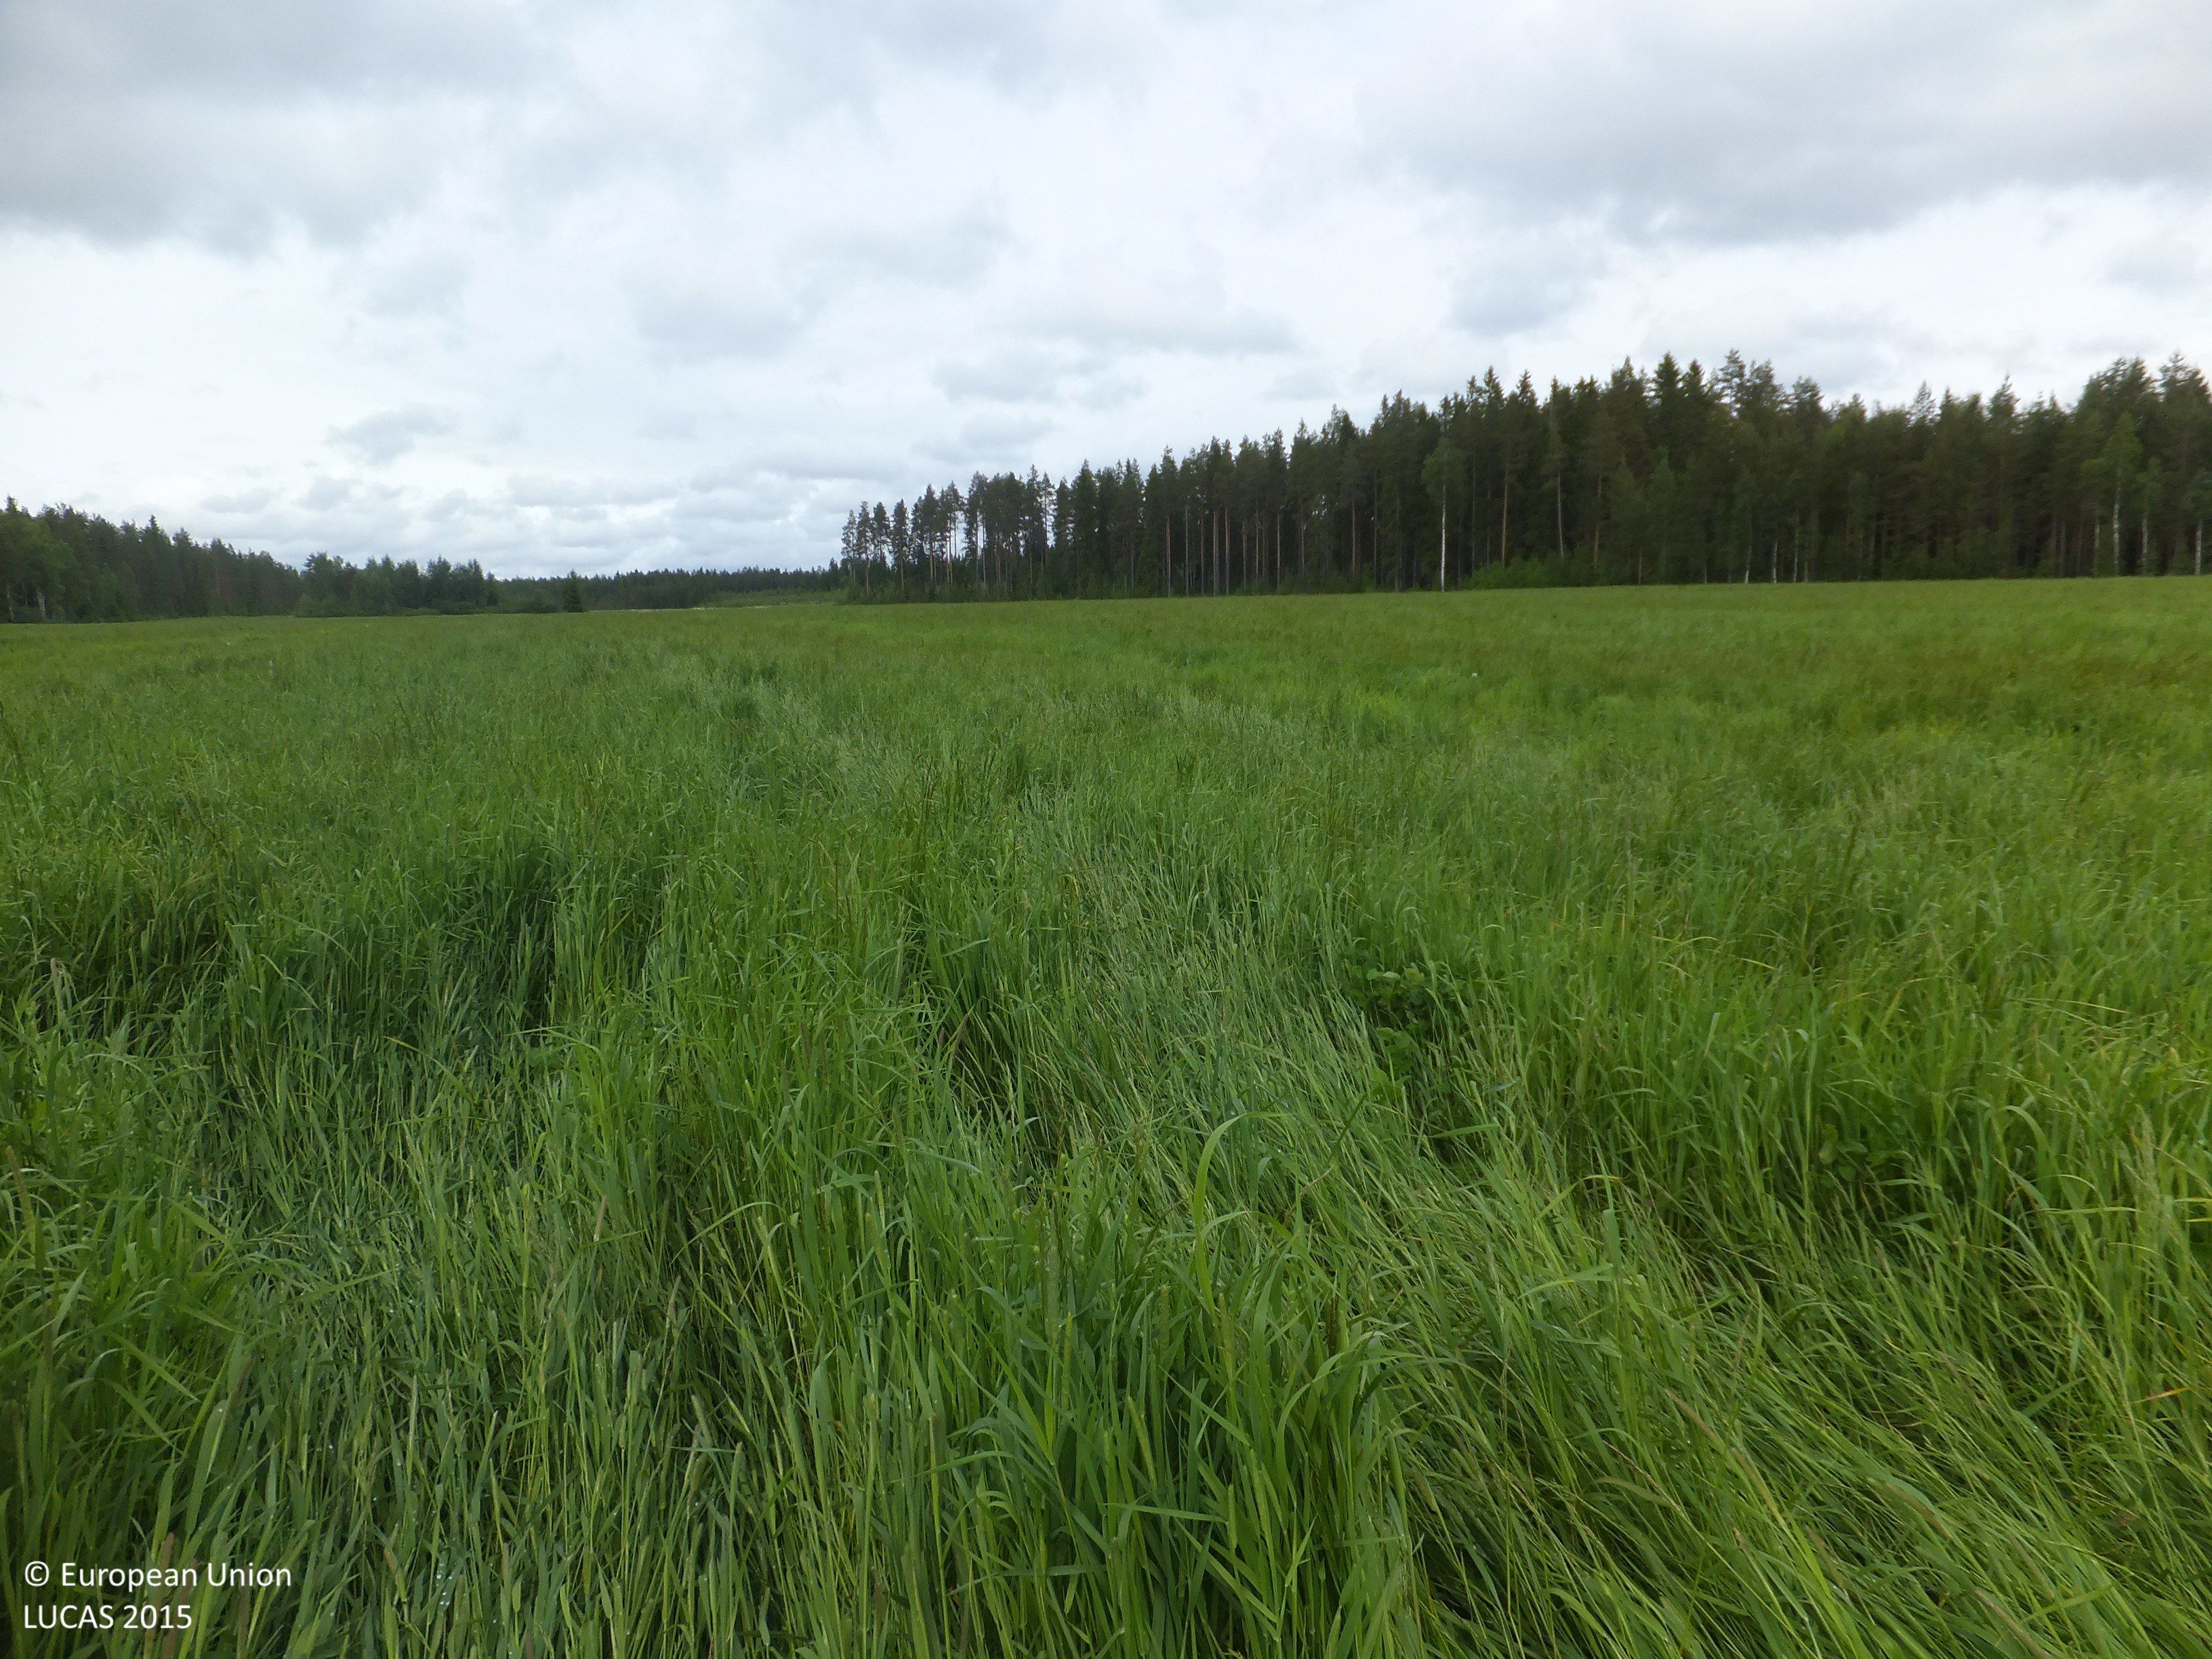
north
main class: Cropland
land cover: Temporary grasslands
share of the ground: > 75 %
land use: Agriculture (excluding fallow land and kitchen gardens)
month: June
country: FI
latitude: 63.3188
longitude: 23.9446
